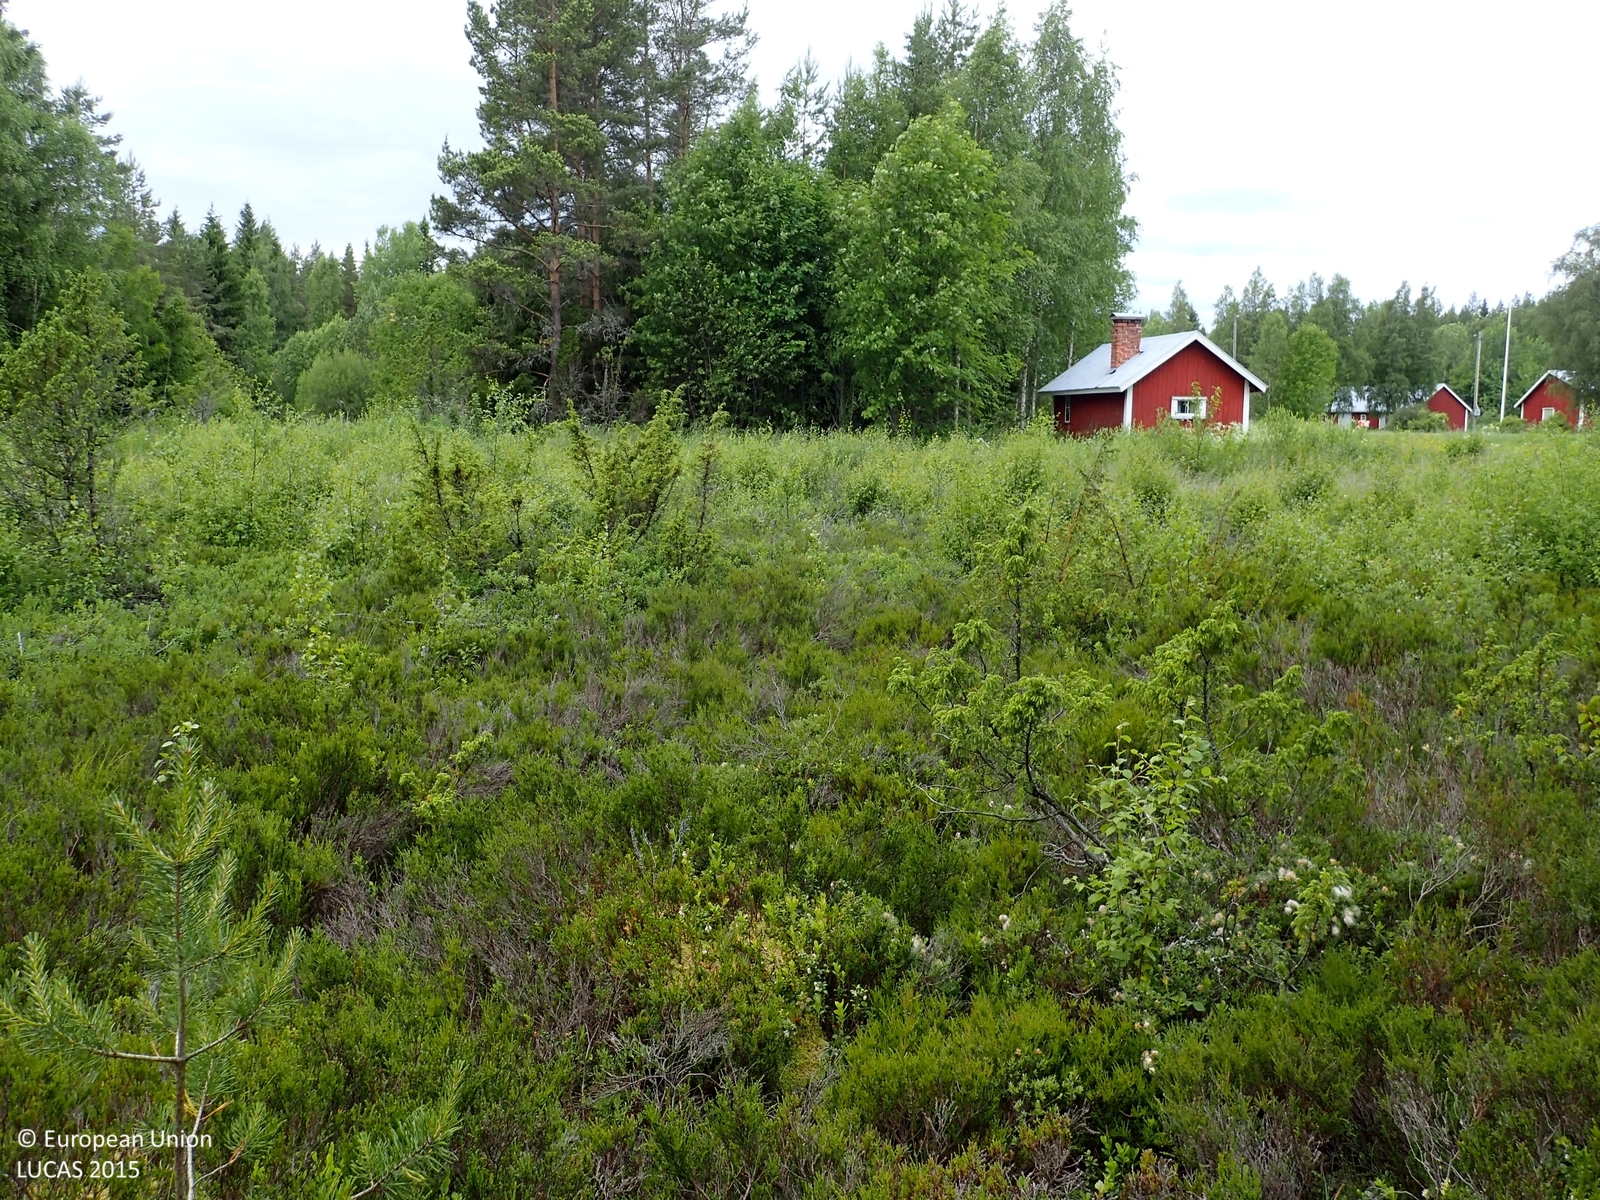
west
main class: Shrubland
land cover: Shrubland with sparse tree cover
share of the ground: > 75 %
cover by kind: shrubs 80 %, herbaceous plants 10 %, broadleaved forest trees 5 %, lichens and mosses 5 %
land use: Electricity, gas and thermal power distribution
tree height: < 5 m
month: July
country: FI
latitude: 62.7371
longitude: 21.7262
